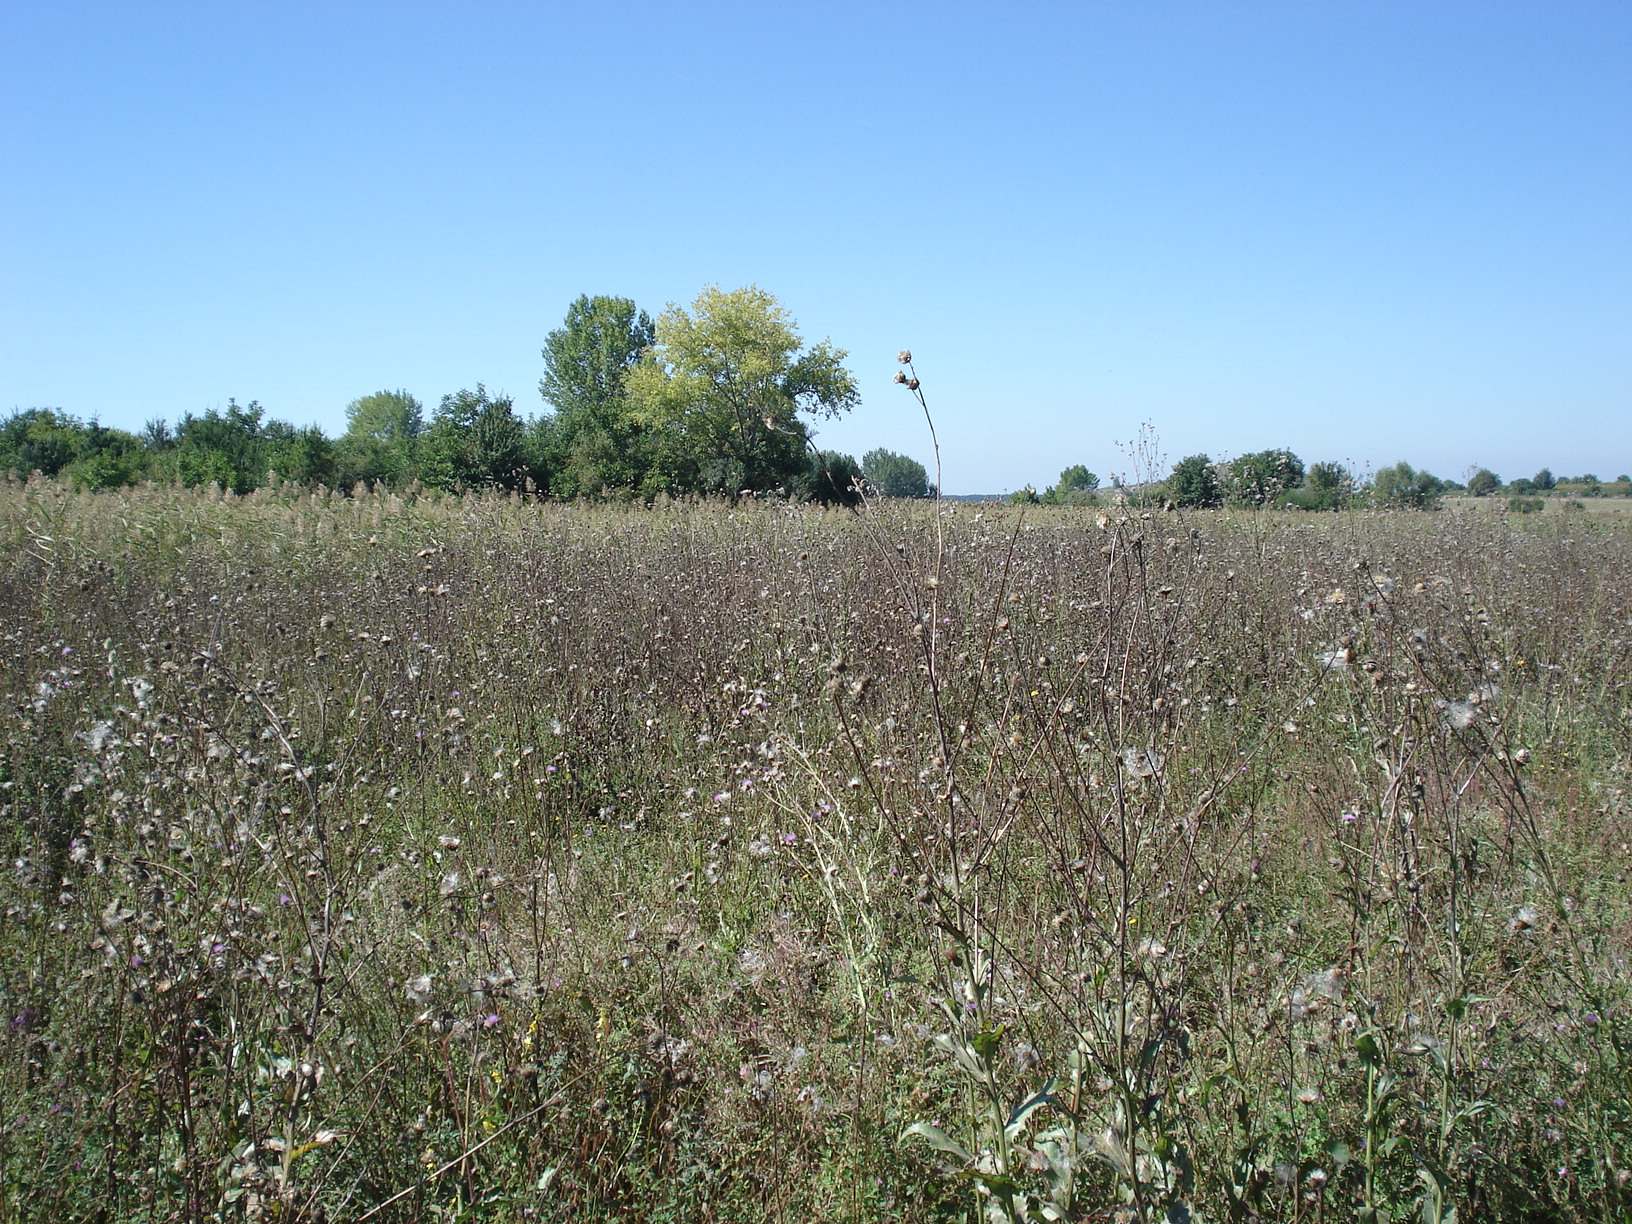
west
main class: Grassland
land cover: Grassland without tree/shrub cover
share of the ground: > 75 %
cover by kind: herbaceous plants 100 %
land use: Semi-natural and natural areas not in use
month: September
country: BG
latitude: 43.2895
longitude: 25.2457
